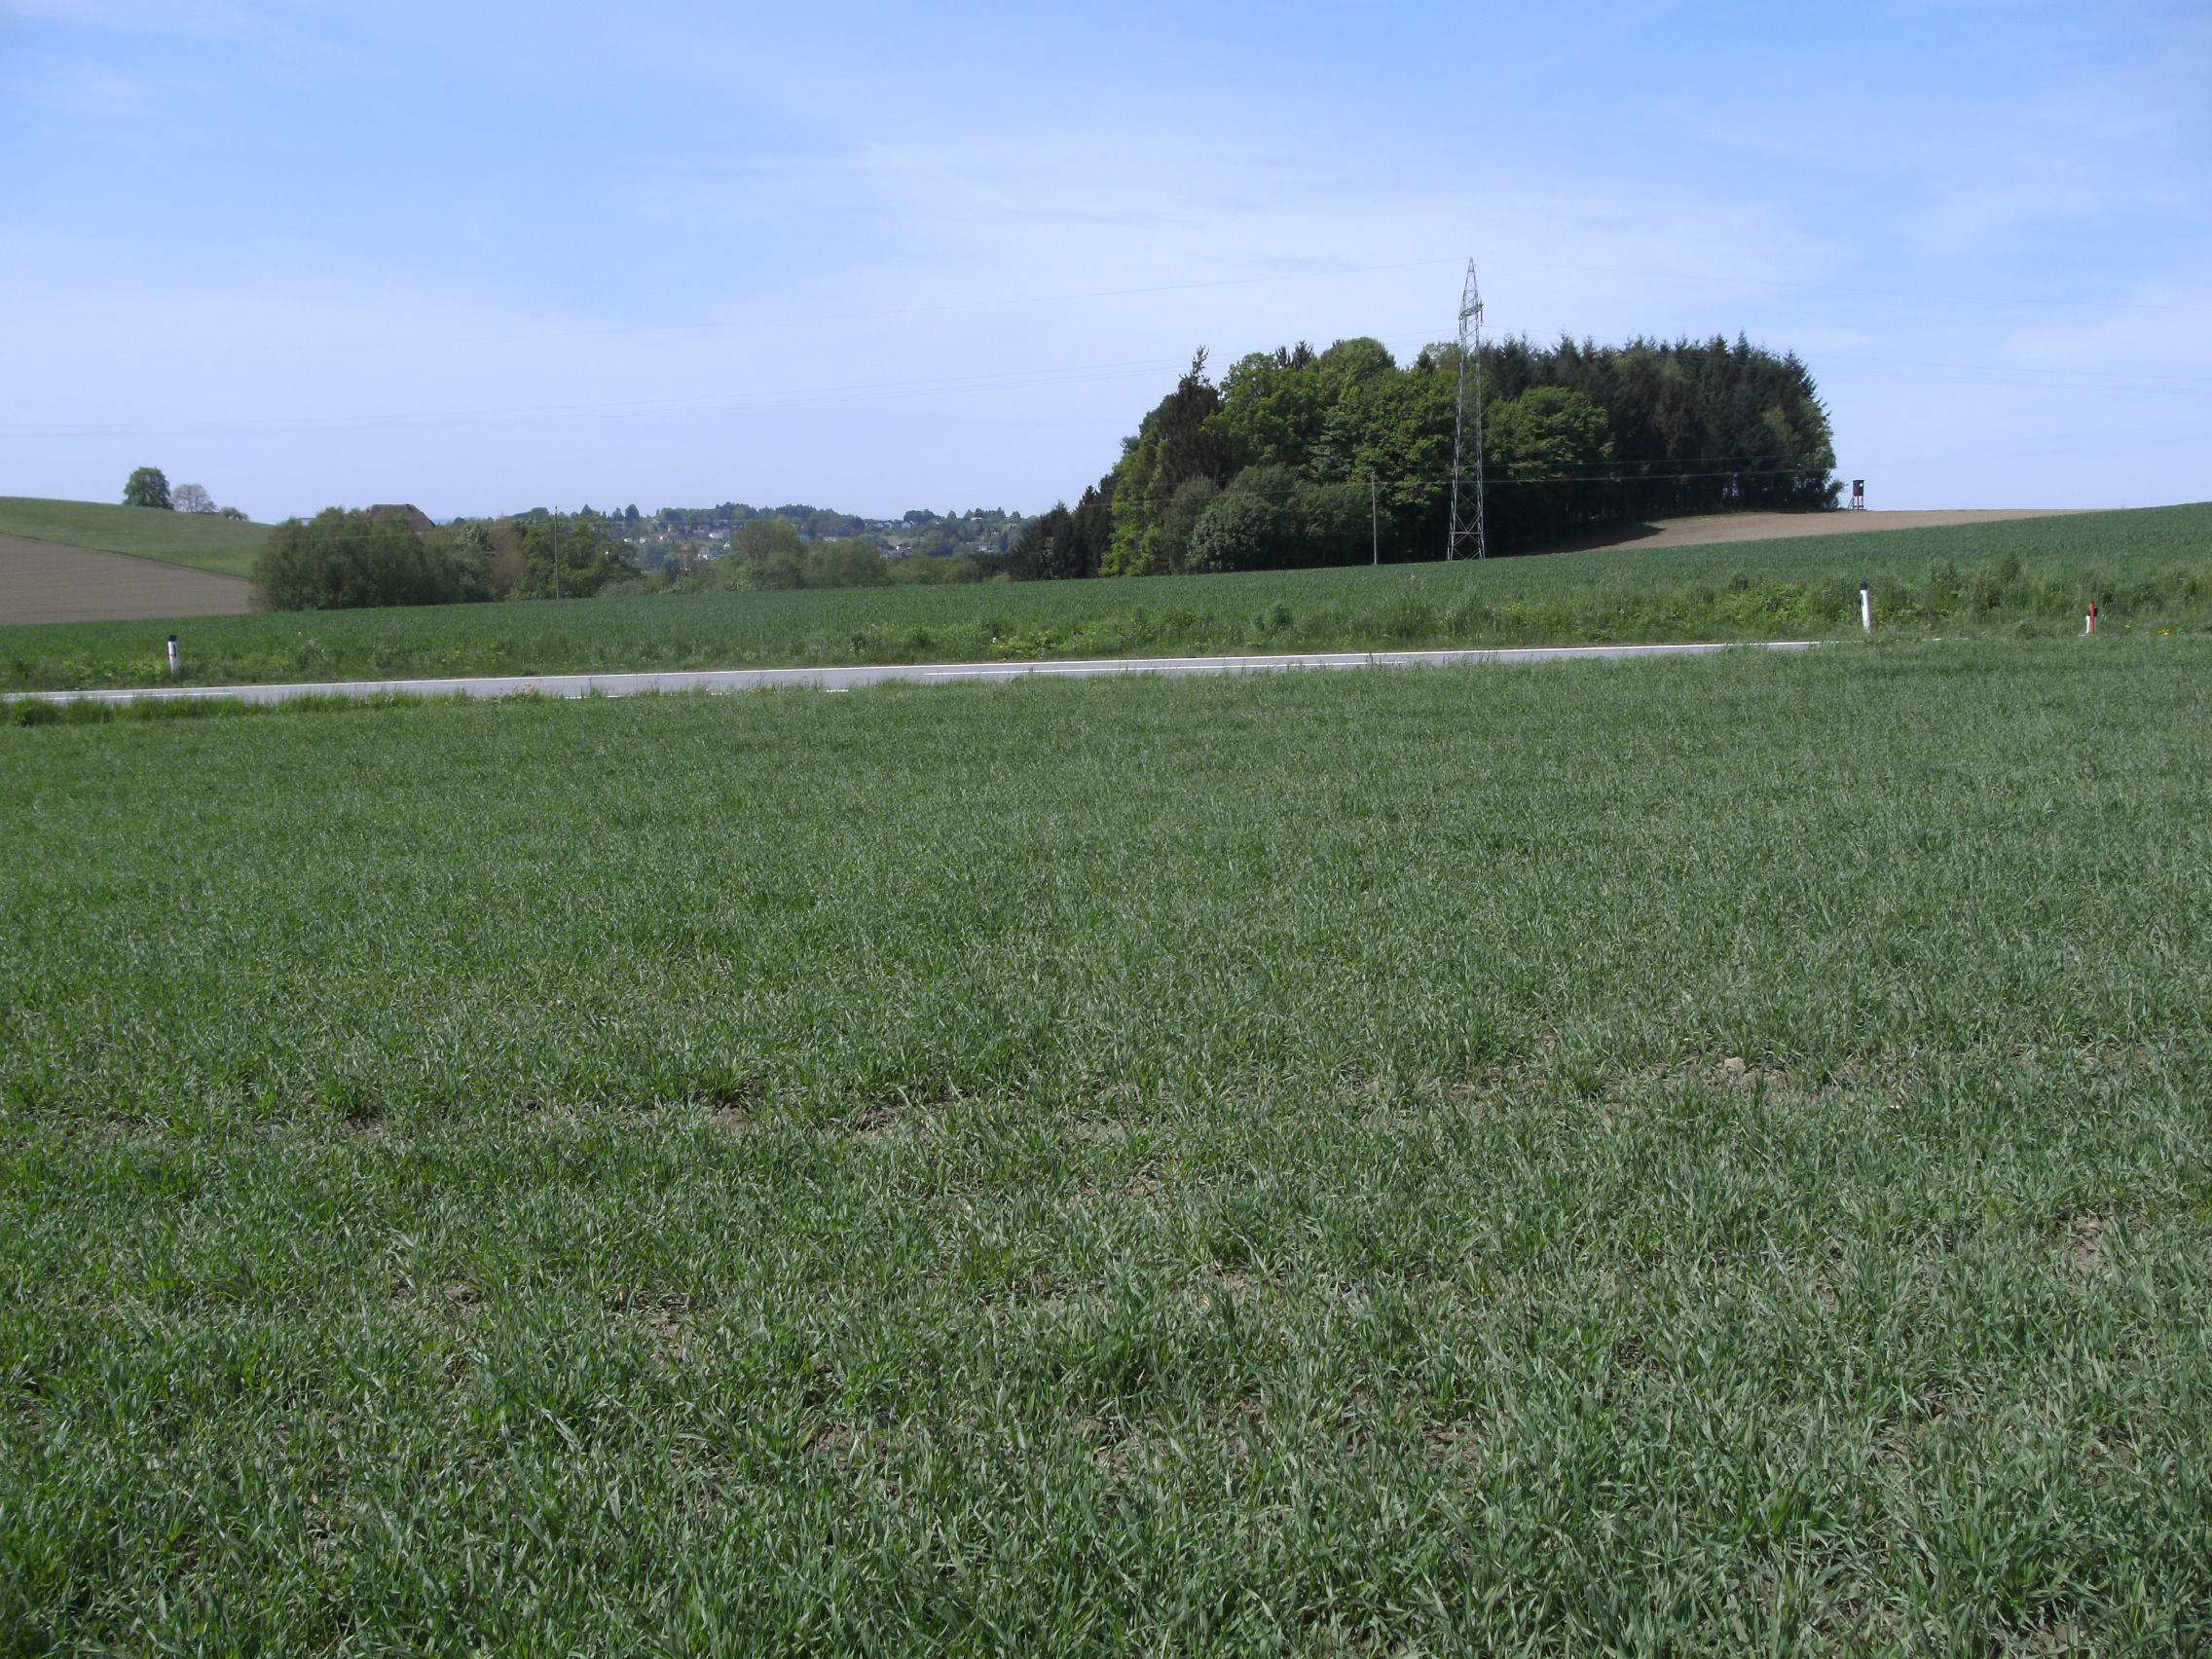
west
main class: Cropland
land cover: Barley
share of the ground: > 75 %
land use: Agriculture (excluding fallow land and kitchen gardens)
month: May
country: AT
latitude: 48.5109
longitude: 13.4785
